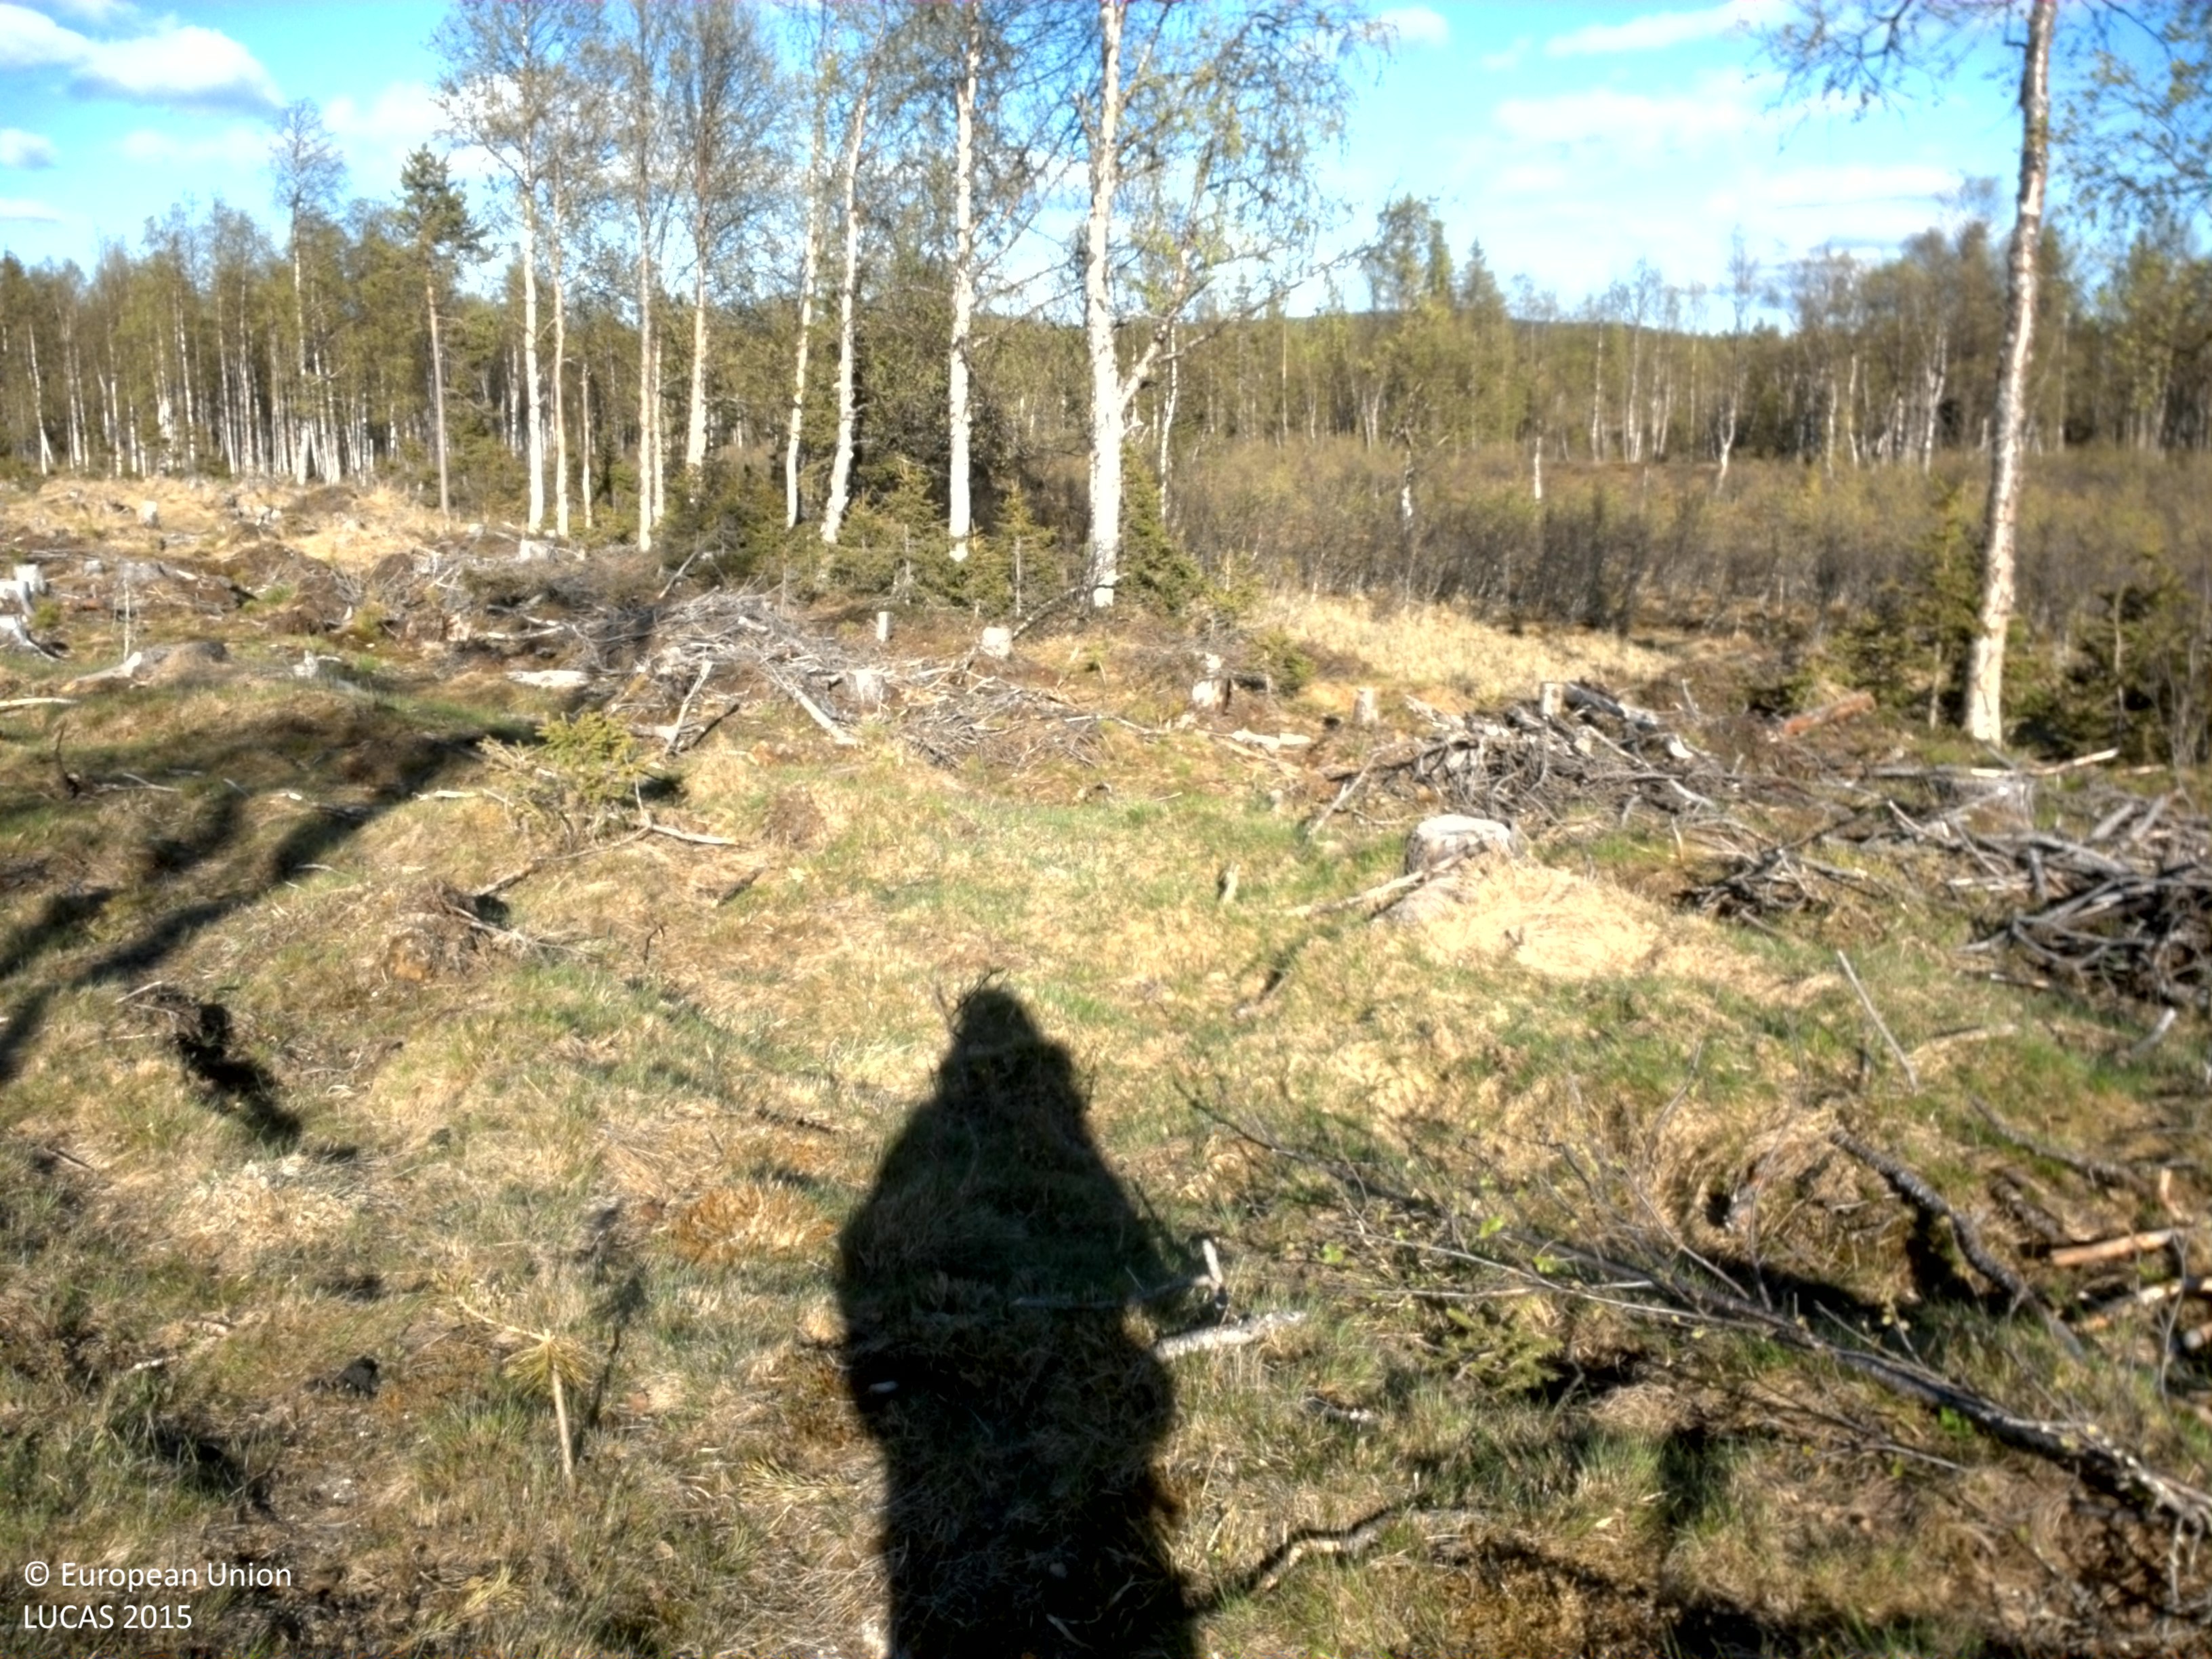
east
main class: Grassland
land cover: Grassland with sparse tree/shrub cover
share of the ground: > 75 %
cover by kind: herbaceous plants 80 %, coniferous forest trees 5 %, shrubs 5 %, lichens and mosses 5 %, unconsolidated bare surface 5 %
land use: Forestry
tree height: > 5 m
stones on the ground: < 10 %
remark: Clear cut
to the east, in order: Grassland with sparse tree/shrub cover; Other mixed woodland; Shrubland with sparse tree cover; Broadleaved woodland; Ditches and canals; Other mixed woodland; Shrubland with sparse tree cover
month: June
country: SE
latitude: 66.8708
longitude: 21.2488
